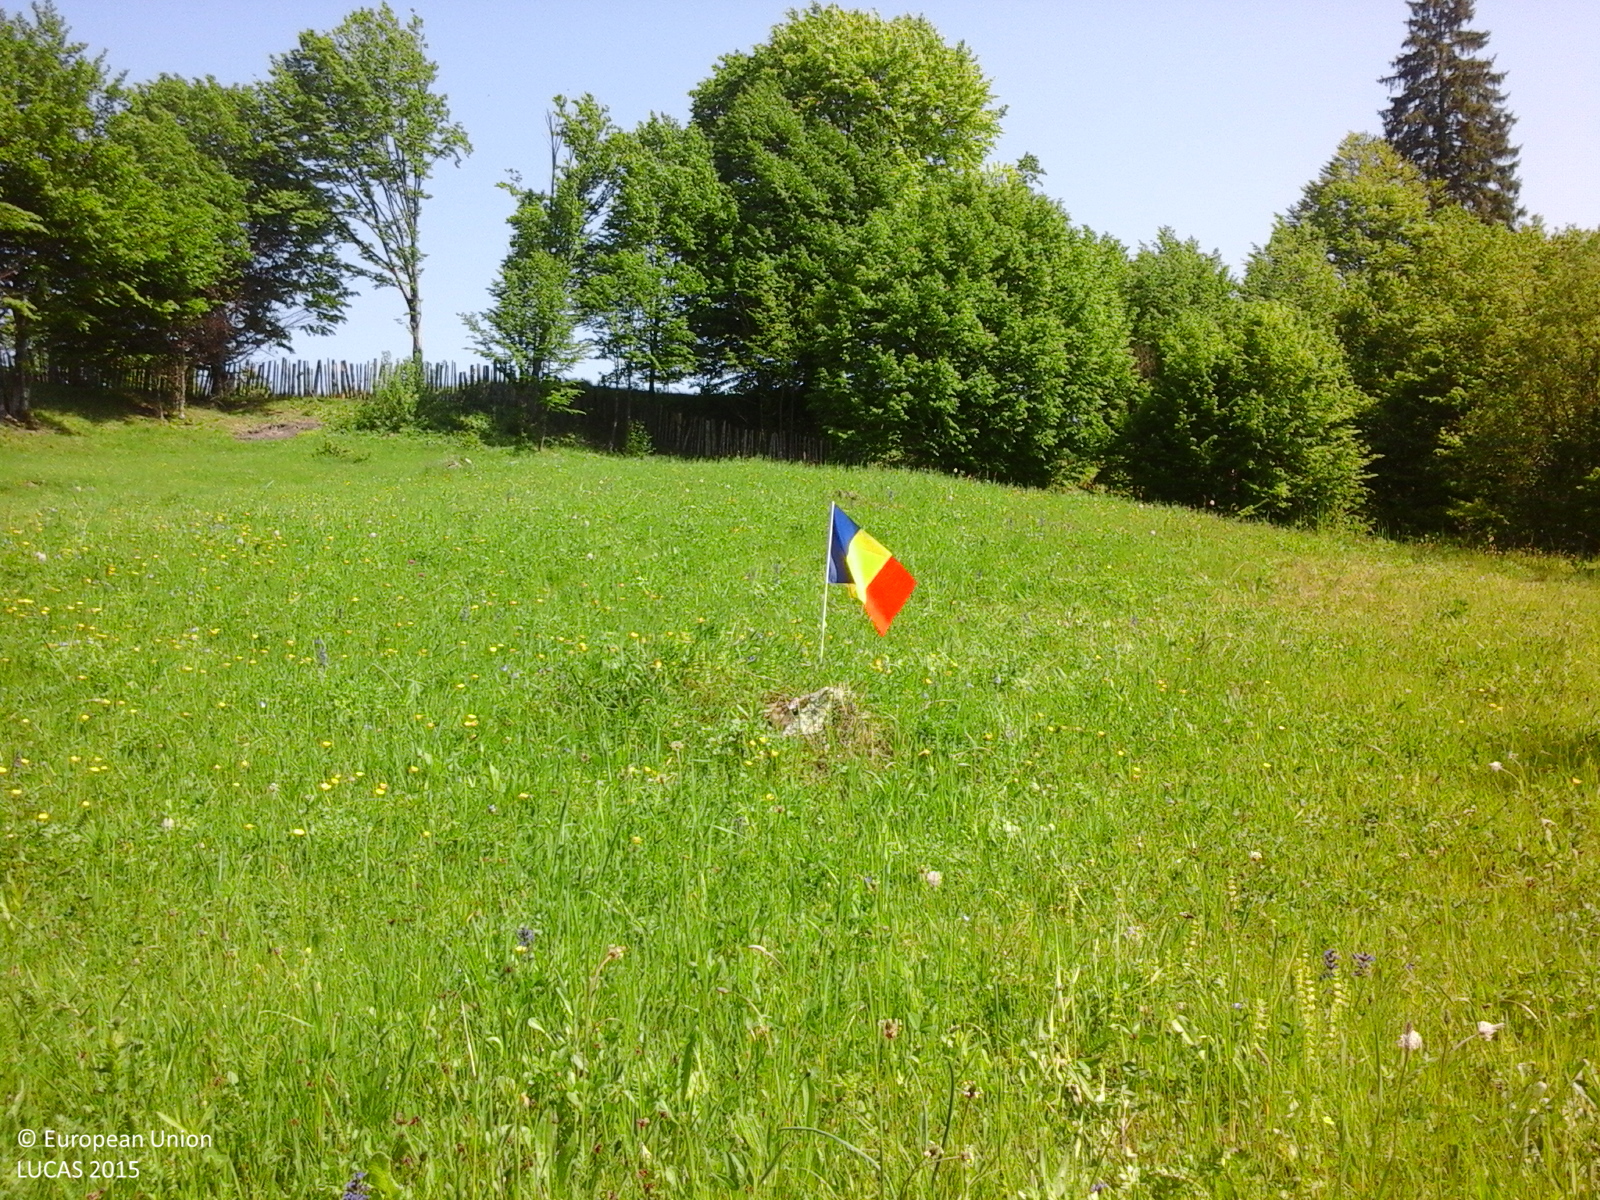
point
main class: Grassland
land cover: Grassland without tree/shrub cover
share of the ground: > 75 %
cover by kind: herbaceous plants 100 %
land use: Agriculture (excluding fallow land and kitchen gardens)
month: May
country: RO
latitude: 45.5904
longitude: 26.1529
